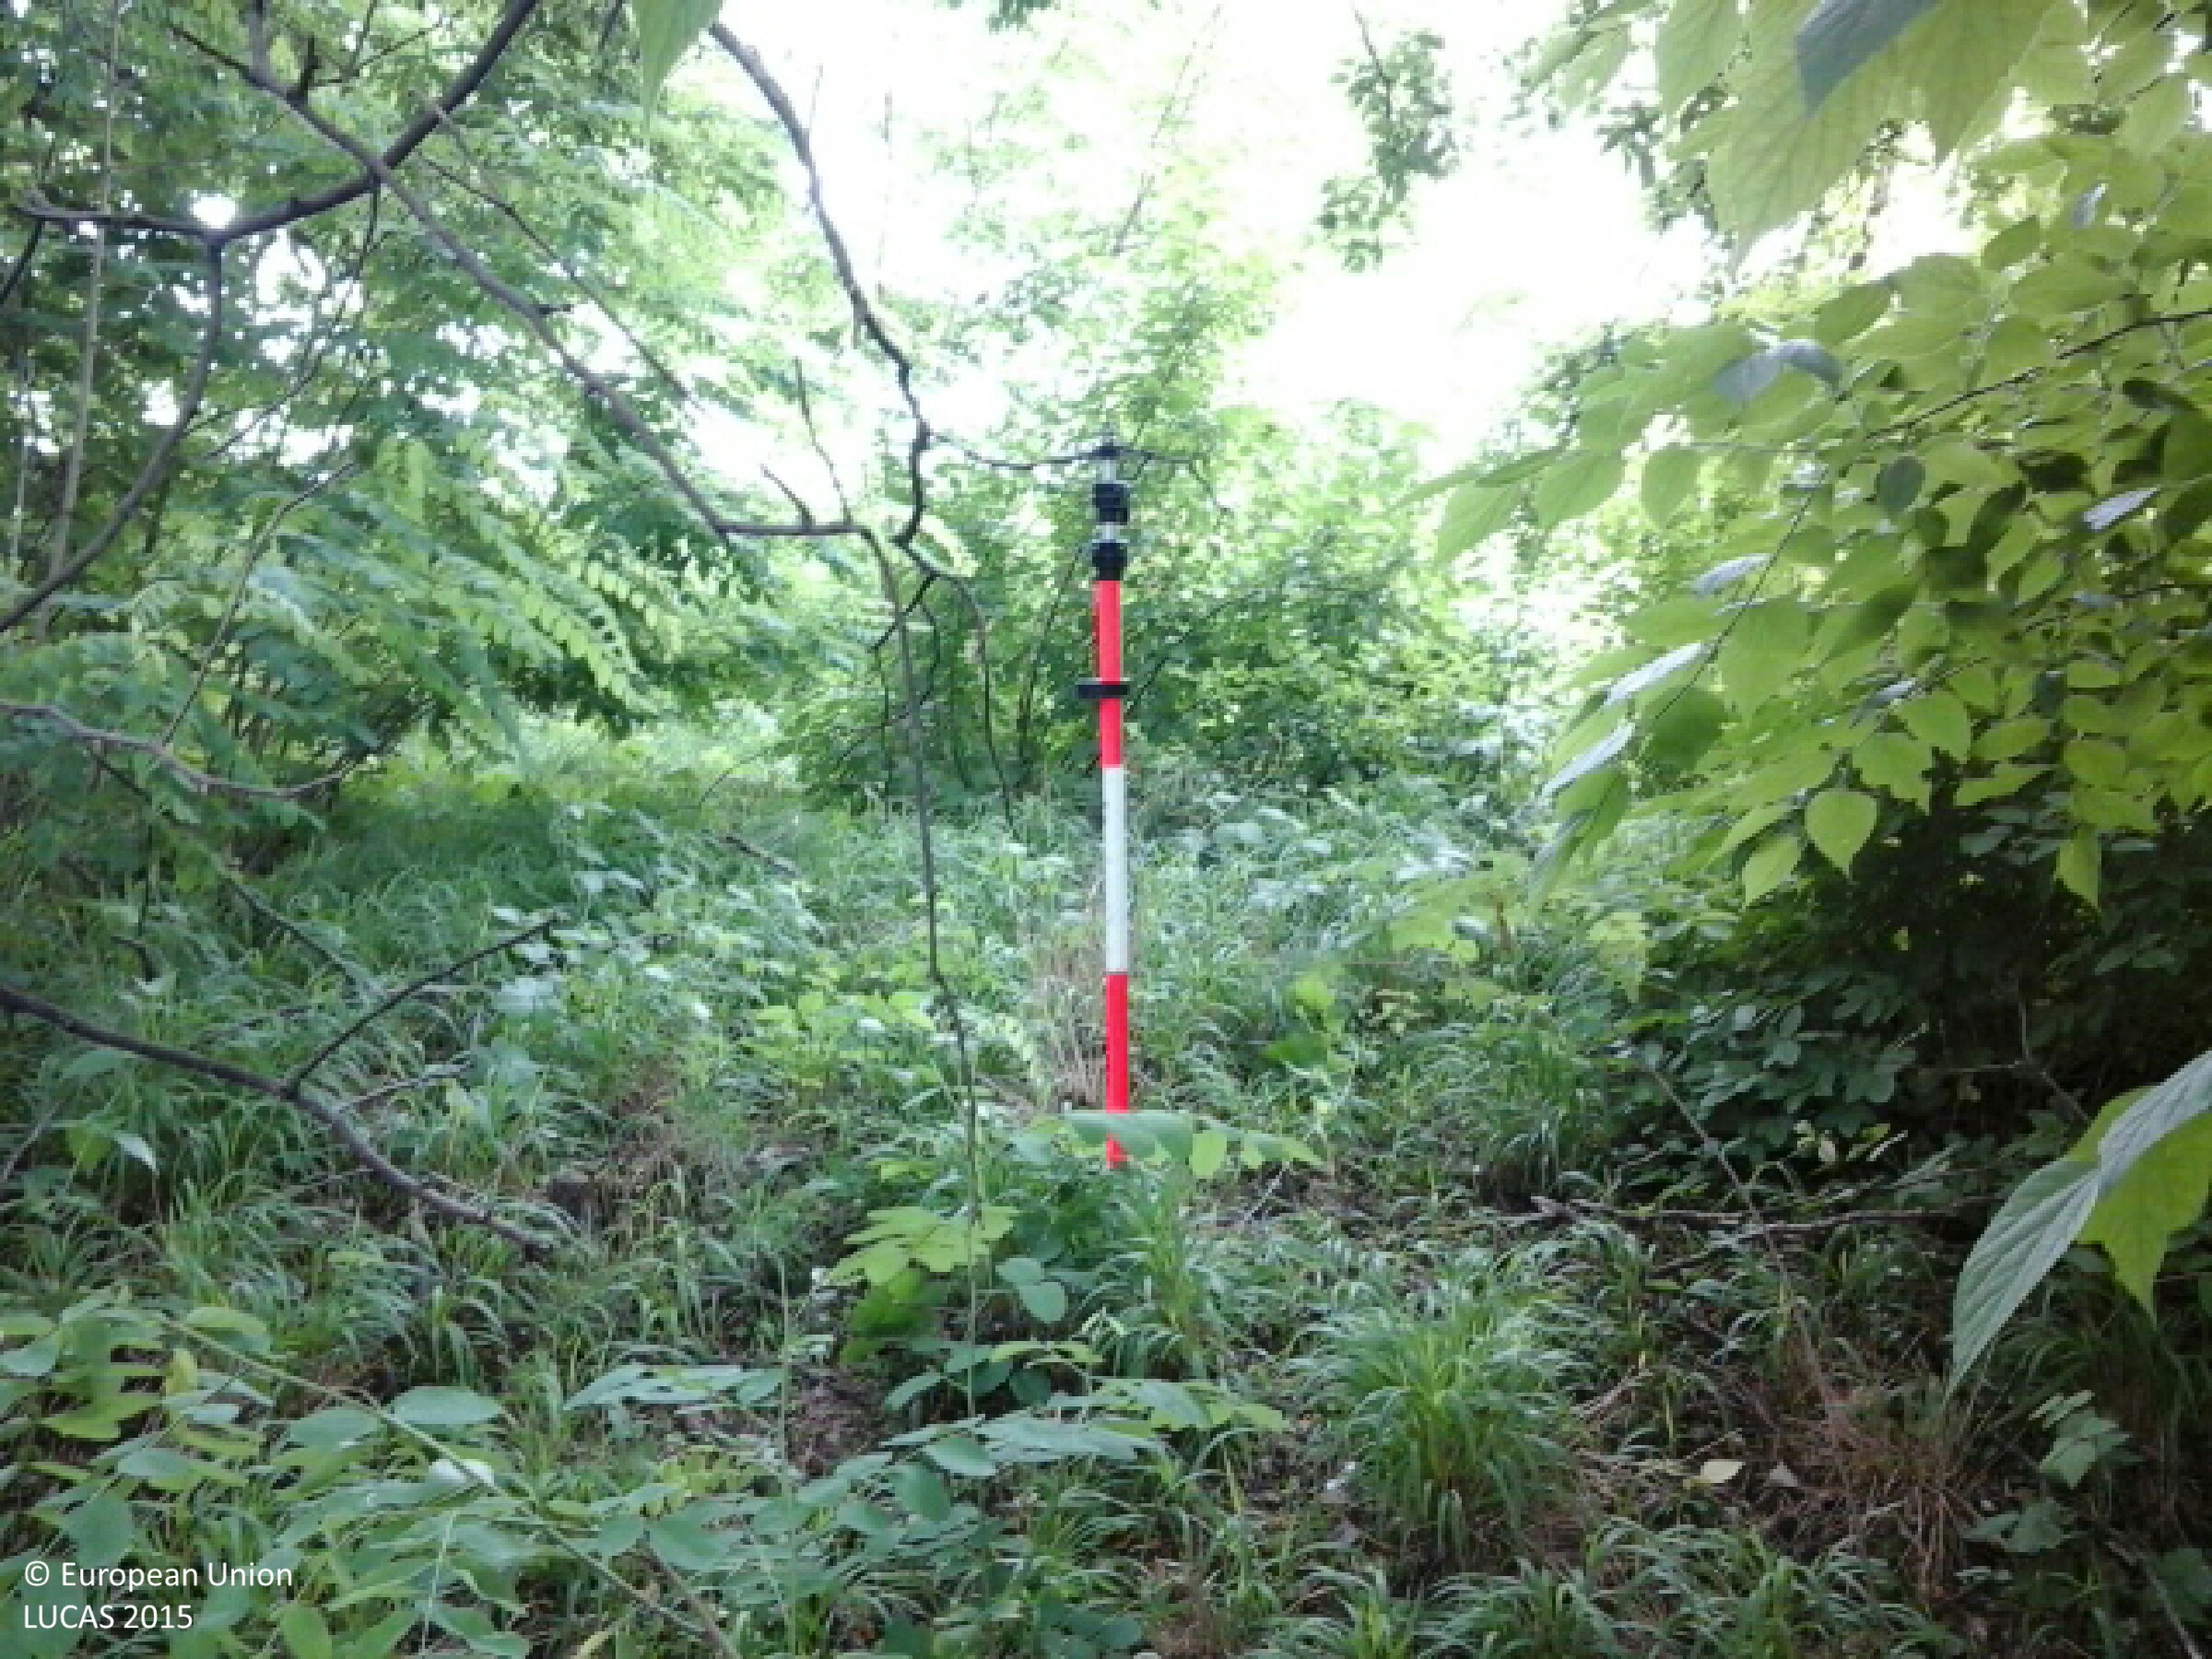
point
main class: Woodland
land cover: Broadleaved woodland
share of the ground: > 75 %
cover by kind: broadleaved forest trees 90 %, shrubs 5 %, herbaceous plants 5 %
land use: Forestry
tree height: > 5 m
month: June
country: HU
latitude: 47.9341
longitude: 21.7879
